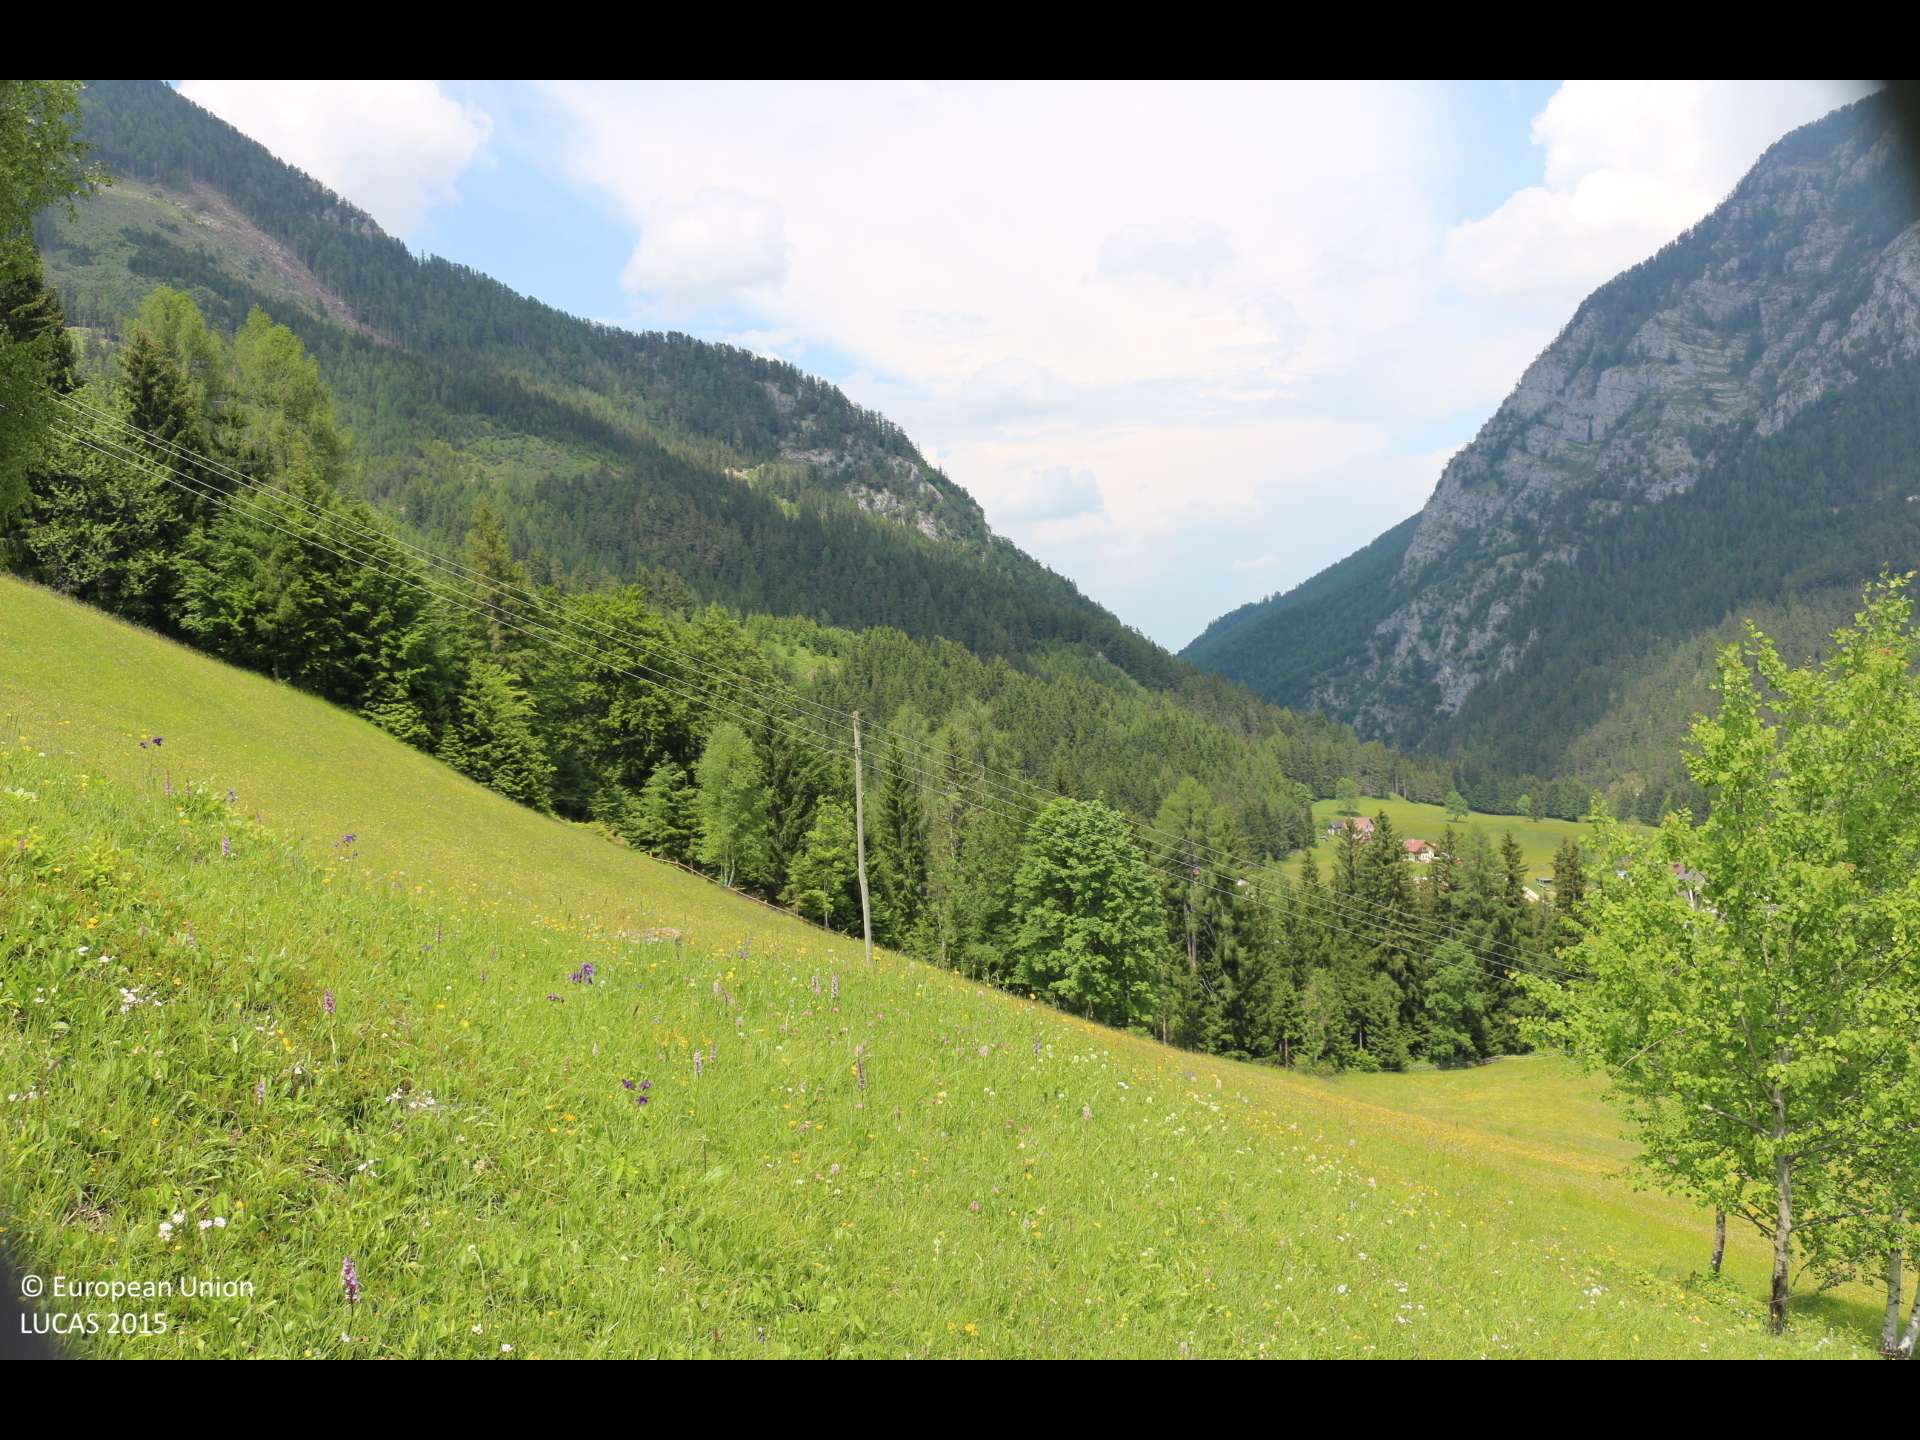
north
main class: Grassland
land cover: Grassland with sparse tree/shrub cover
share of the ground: > 75 %
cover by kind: herbaceous plants 95 %, broadleaved forest trees 5 %
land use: Agriculture (excluding fallow land and kitchen gardens)
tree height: < 5 m
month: June
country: AT
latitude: 46.4756
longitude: 14.4386
